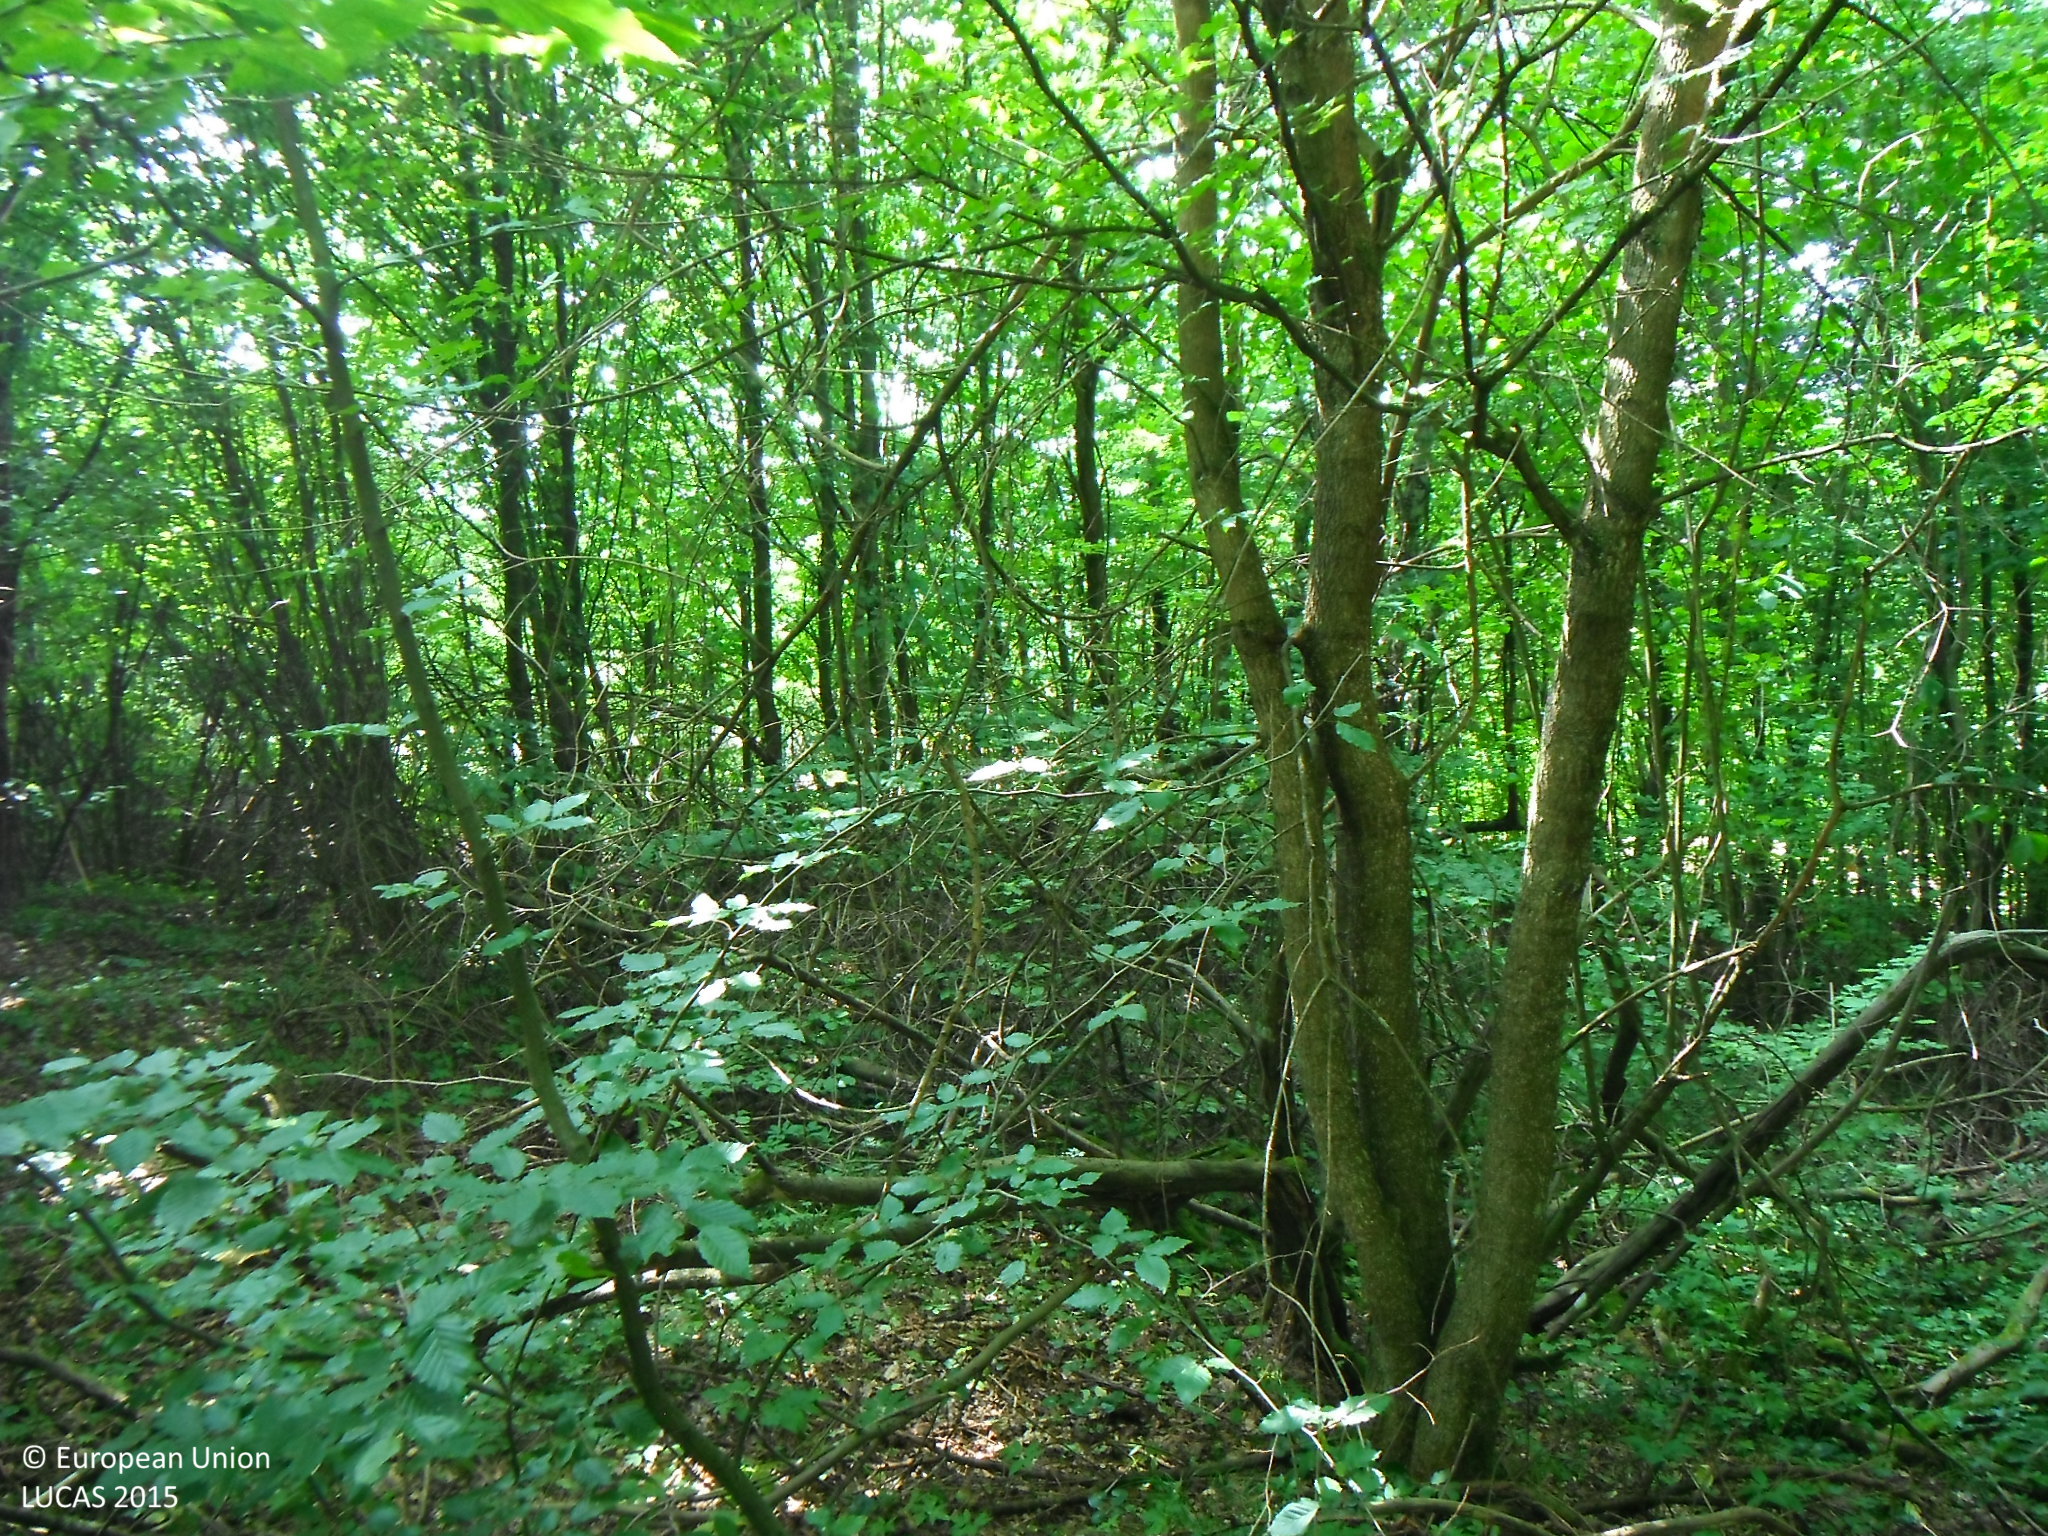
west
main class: Woodland
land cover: Broadleaved woodland
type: mesophytic deciduous forest
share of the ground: > 75 %
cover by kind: broadleaved forest trees 90 %, coniferous forest trees 10 %
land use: Forestry
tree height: > 5 m
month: July
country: SK
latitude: 49.1628
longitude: 22.0284
